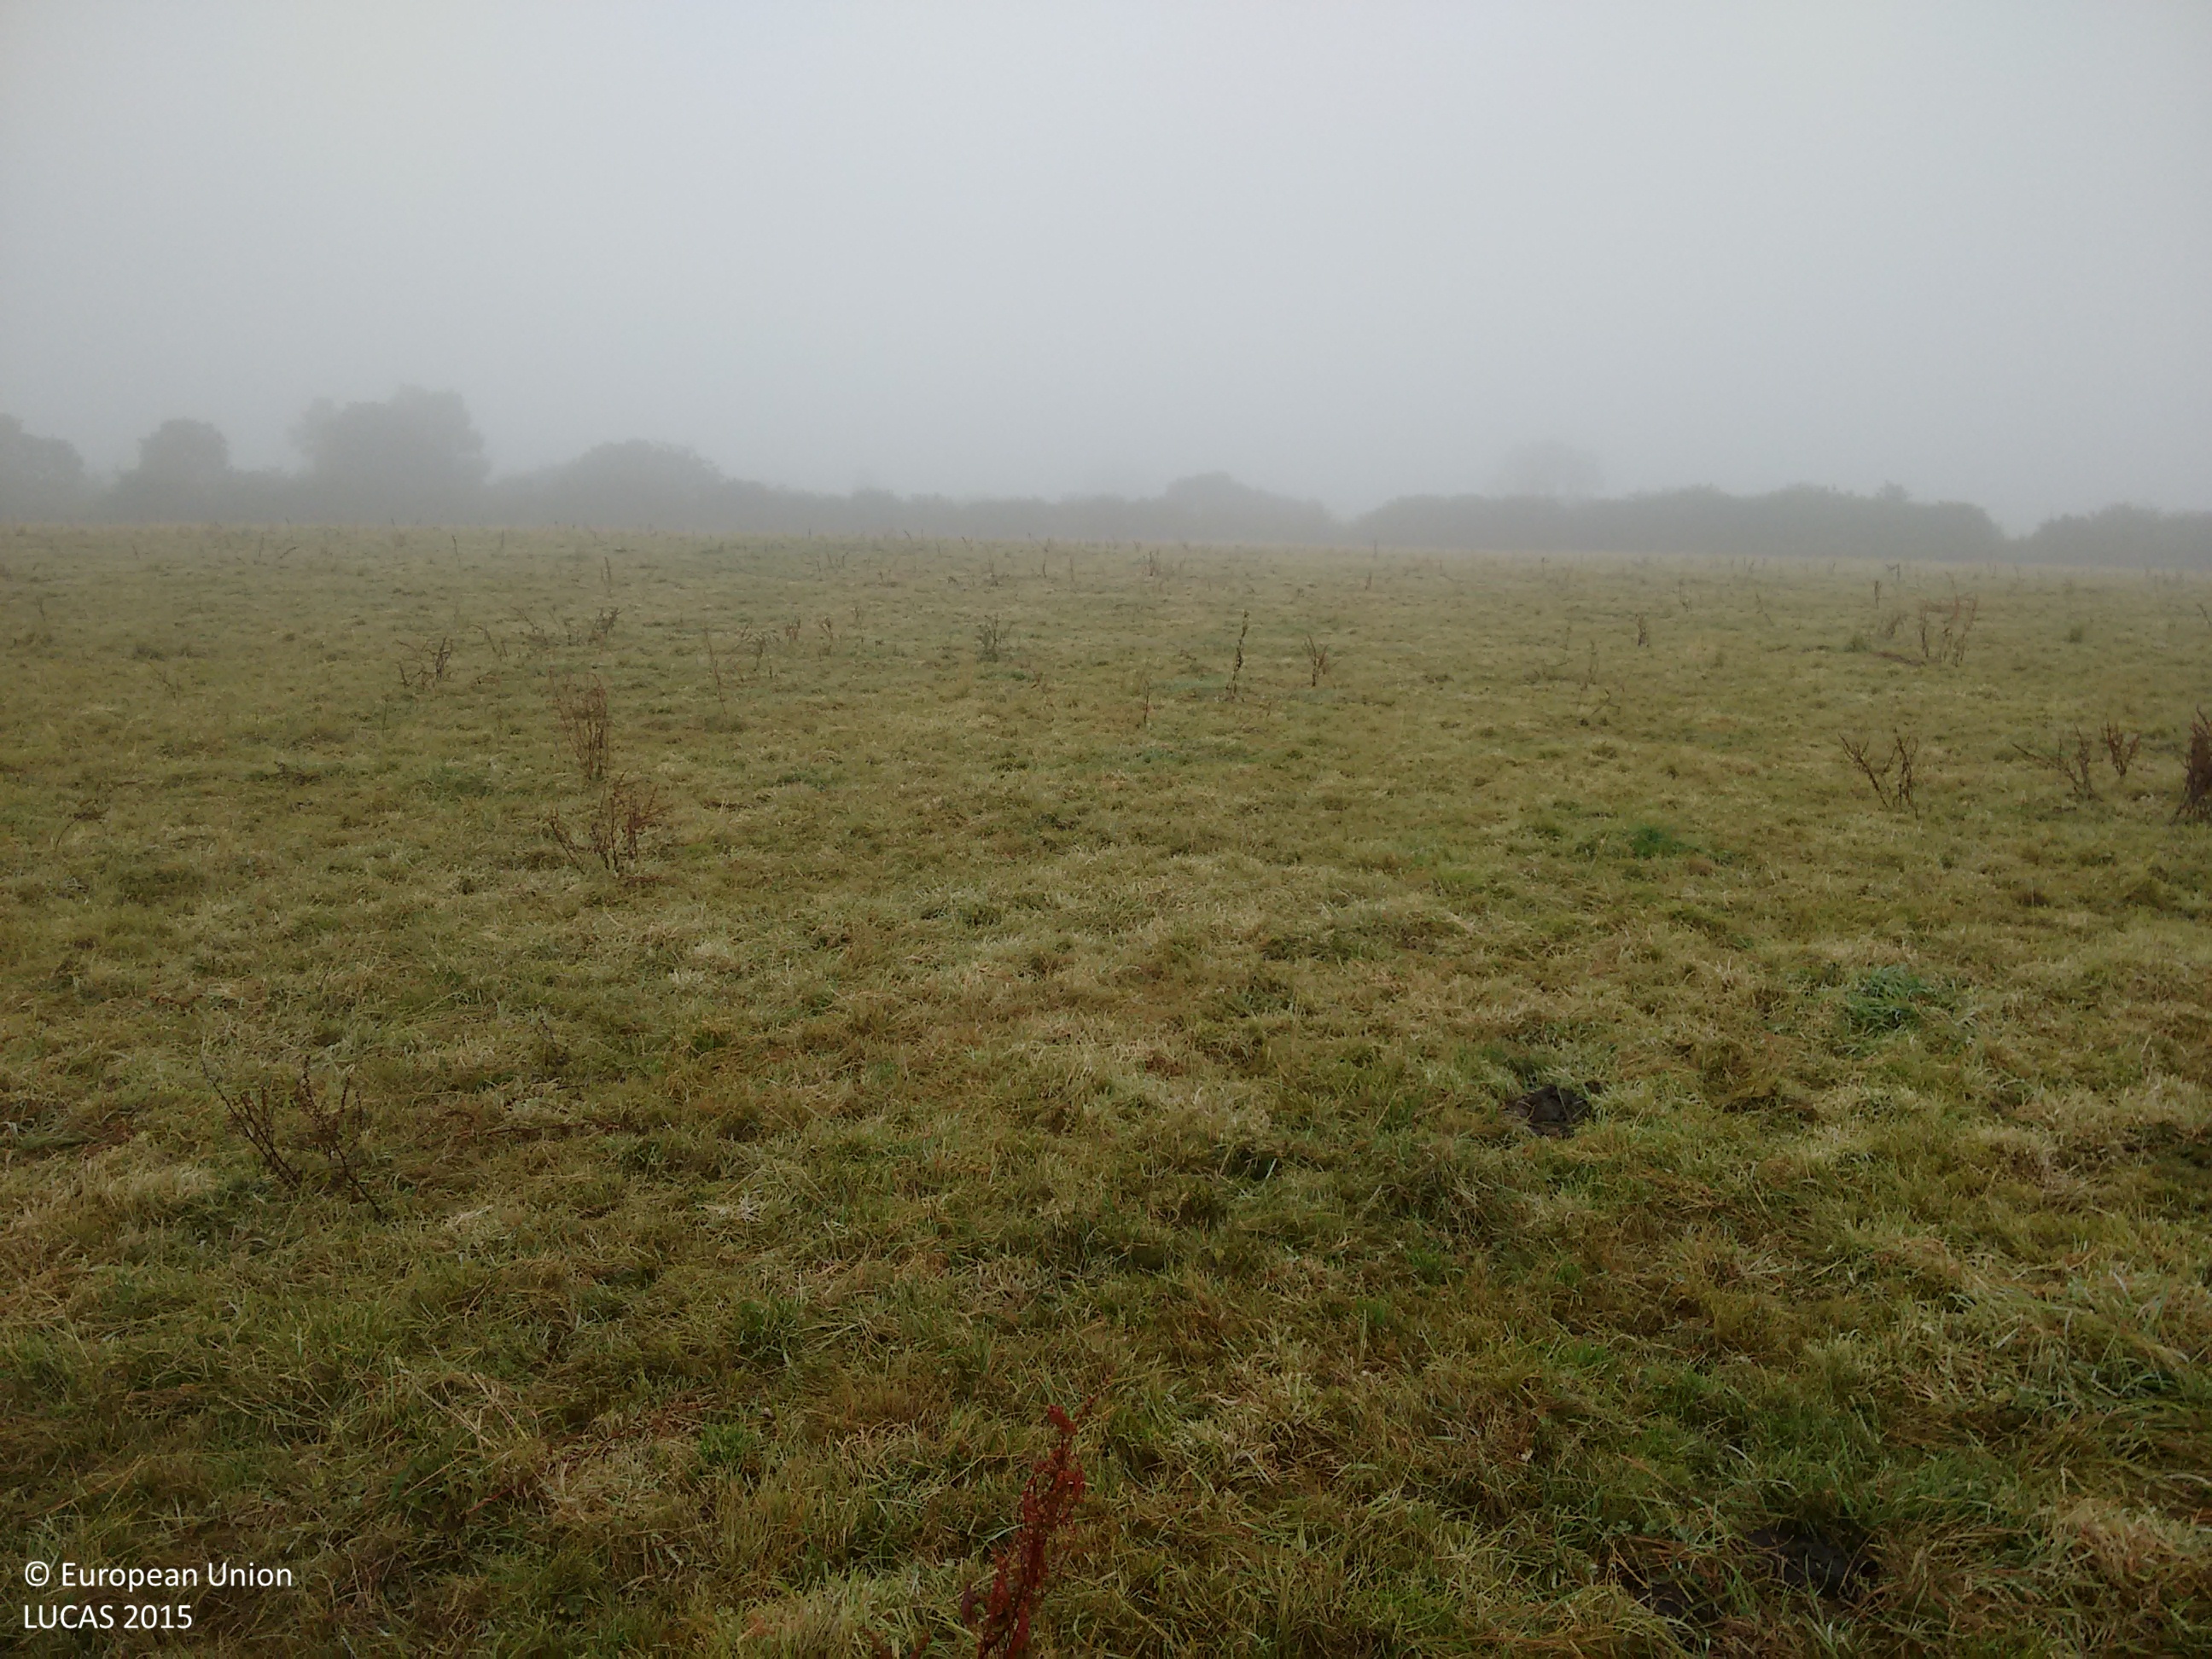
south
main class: Grassland
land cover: Grassland without tree/shrub cover
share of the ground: > 75 %
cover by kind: herbaceous plants 100 %
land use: Agriculture (excluding fallow land and kitchen gardens)
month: October
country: IE
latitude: 52.4448
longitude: -9.0314
